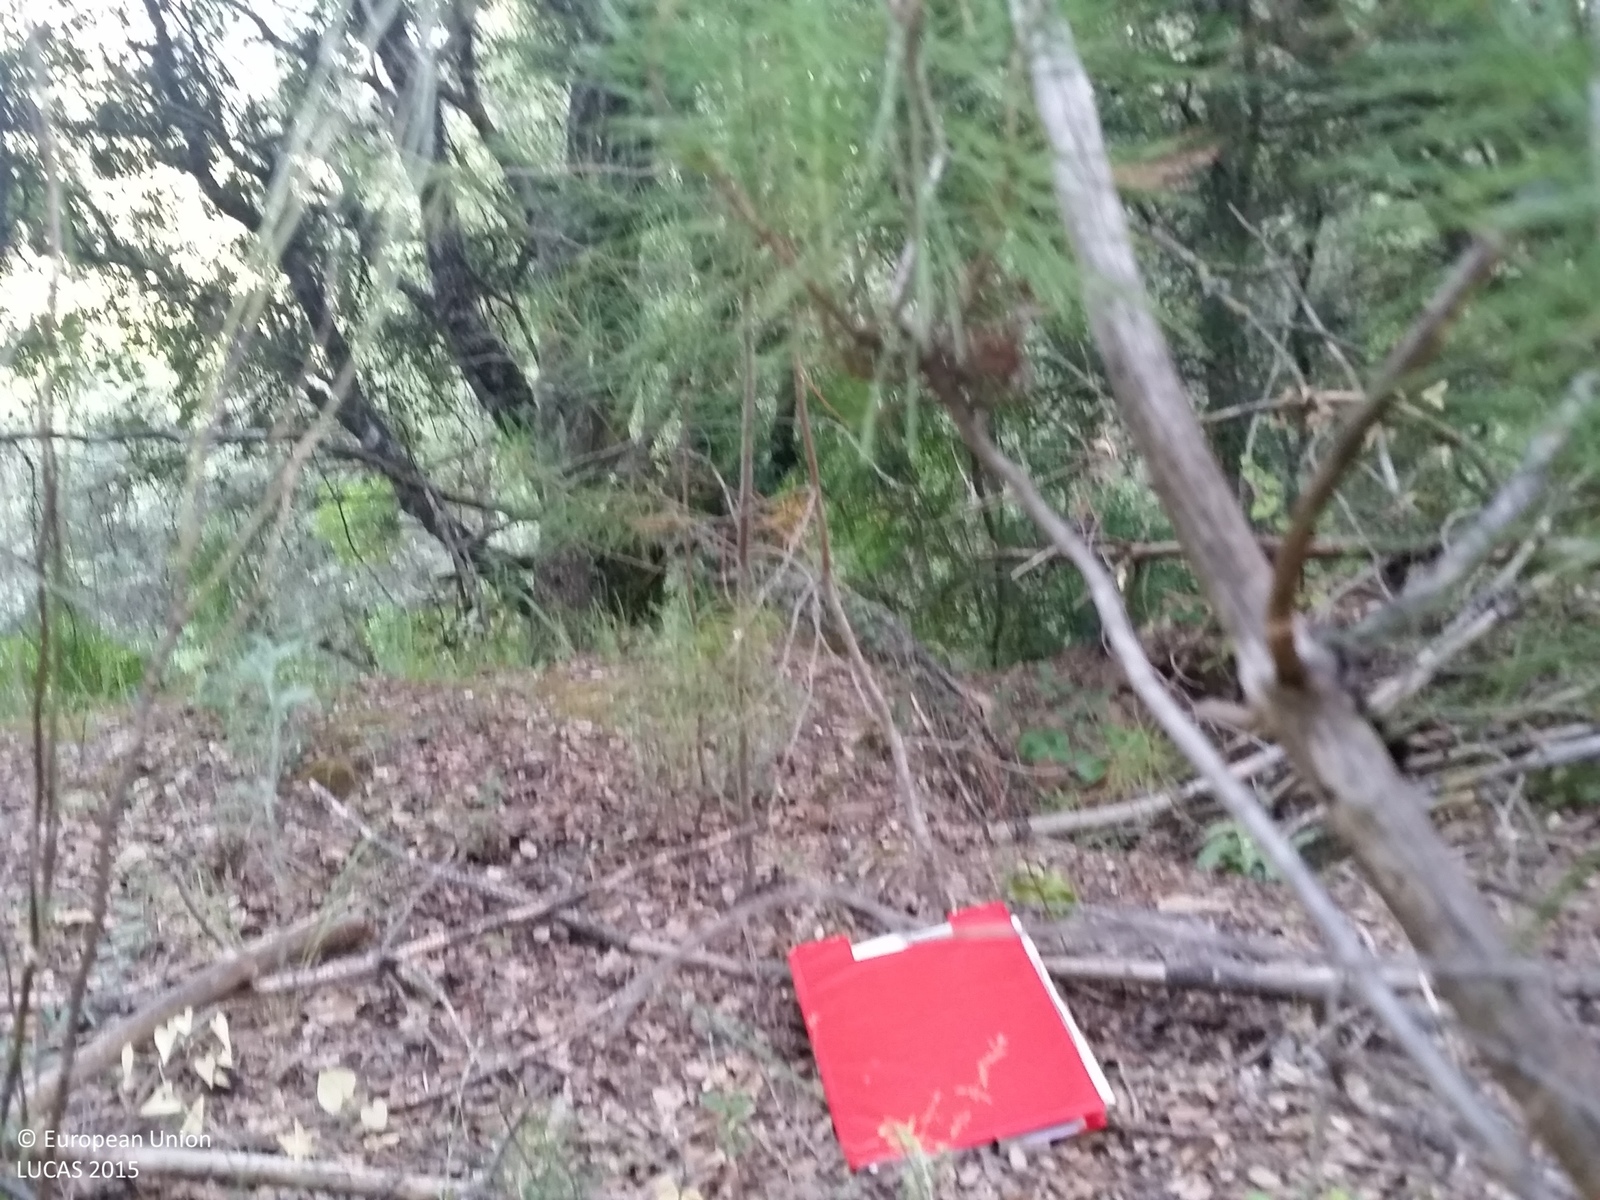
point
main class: Woodland
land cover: Other mixed woodland
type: coniferous forest of the mediterranean region
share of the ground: > 75 %
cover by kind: coniferous forest trees 35 %, broadleaved forest trees 35 %, shrubs 25 %, herbaceous plants 5 %
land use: Semi-natural and natural areas not in use
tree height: > 5 m
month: July
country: ES
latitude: 38.3745
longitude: -2.4392
